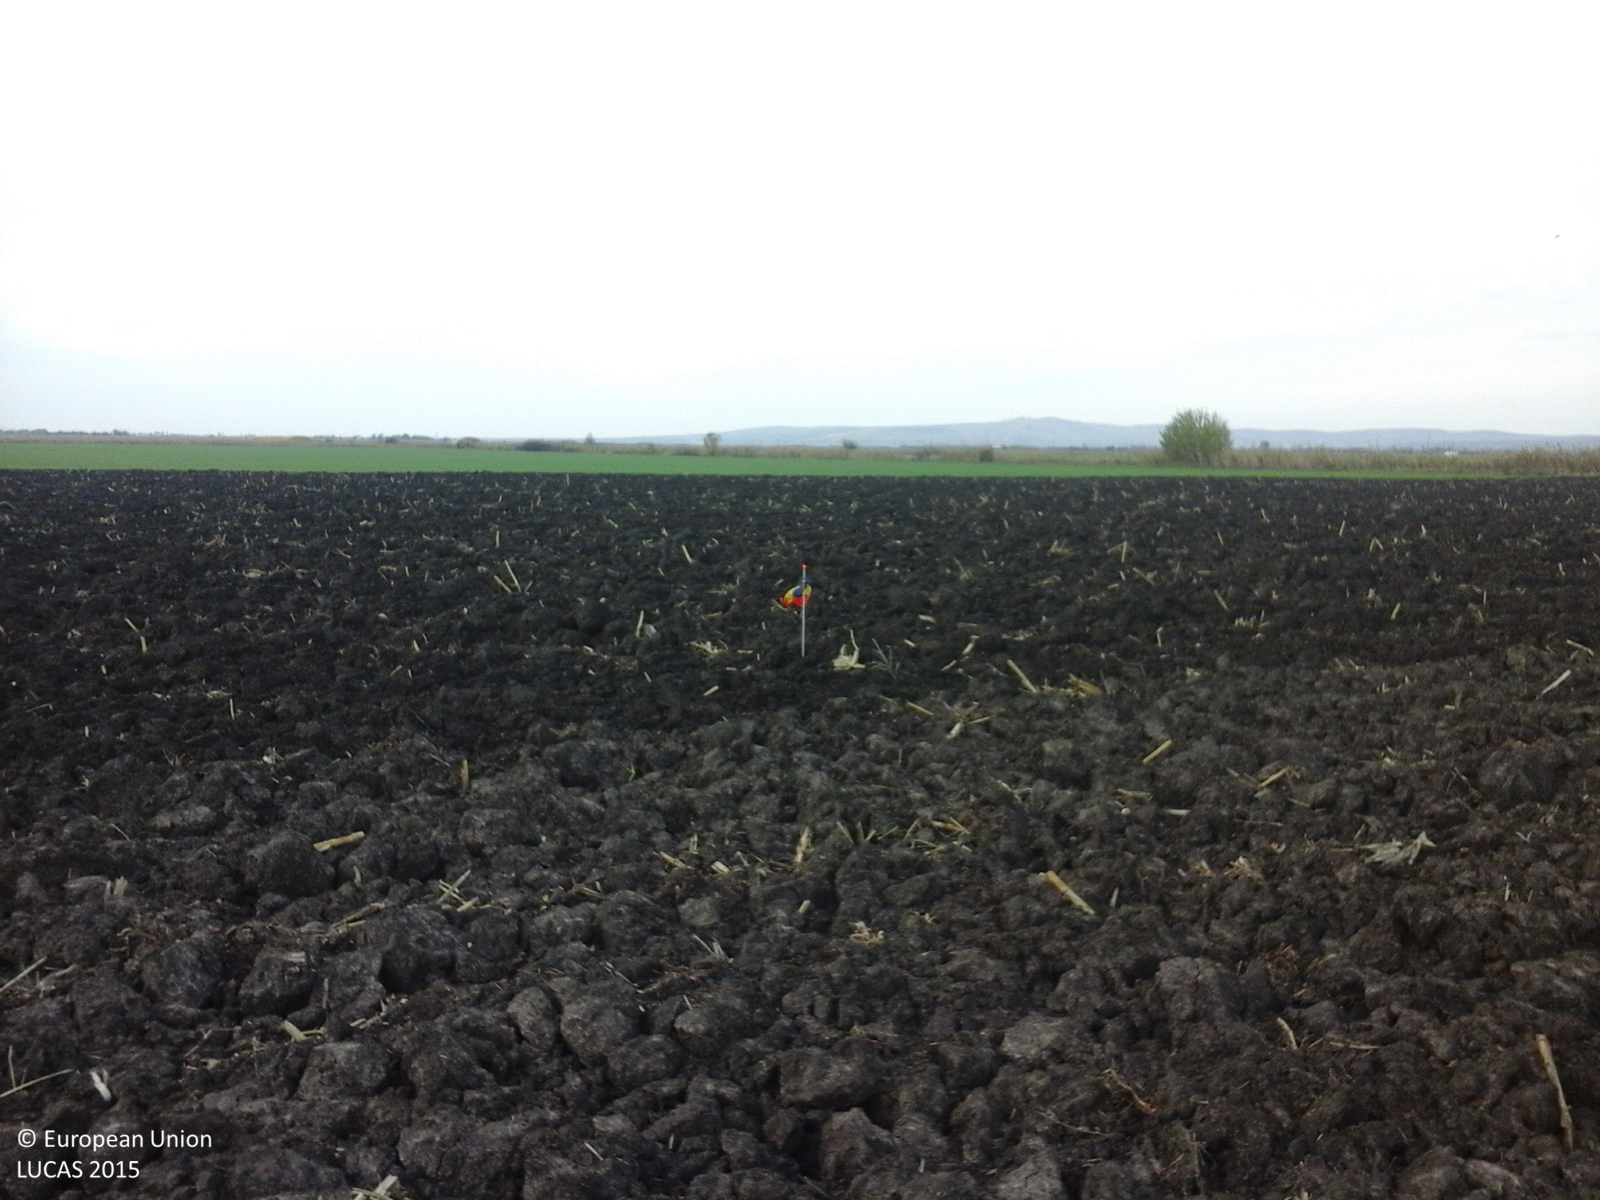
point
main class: Cropland
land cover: Maize
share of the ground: < 10 %
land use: Agriculture (excluding fallow land and kitchen gardens)
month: October
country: RO
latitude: 44.9570
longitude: 26.3290
